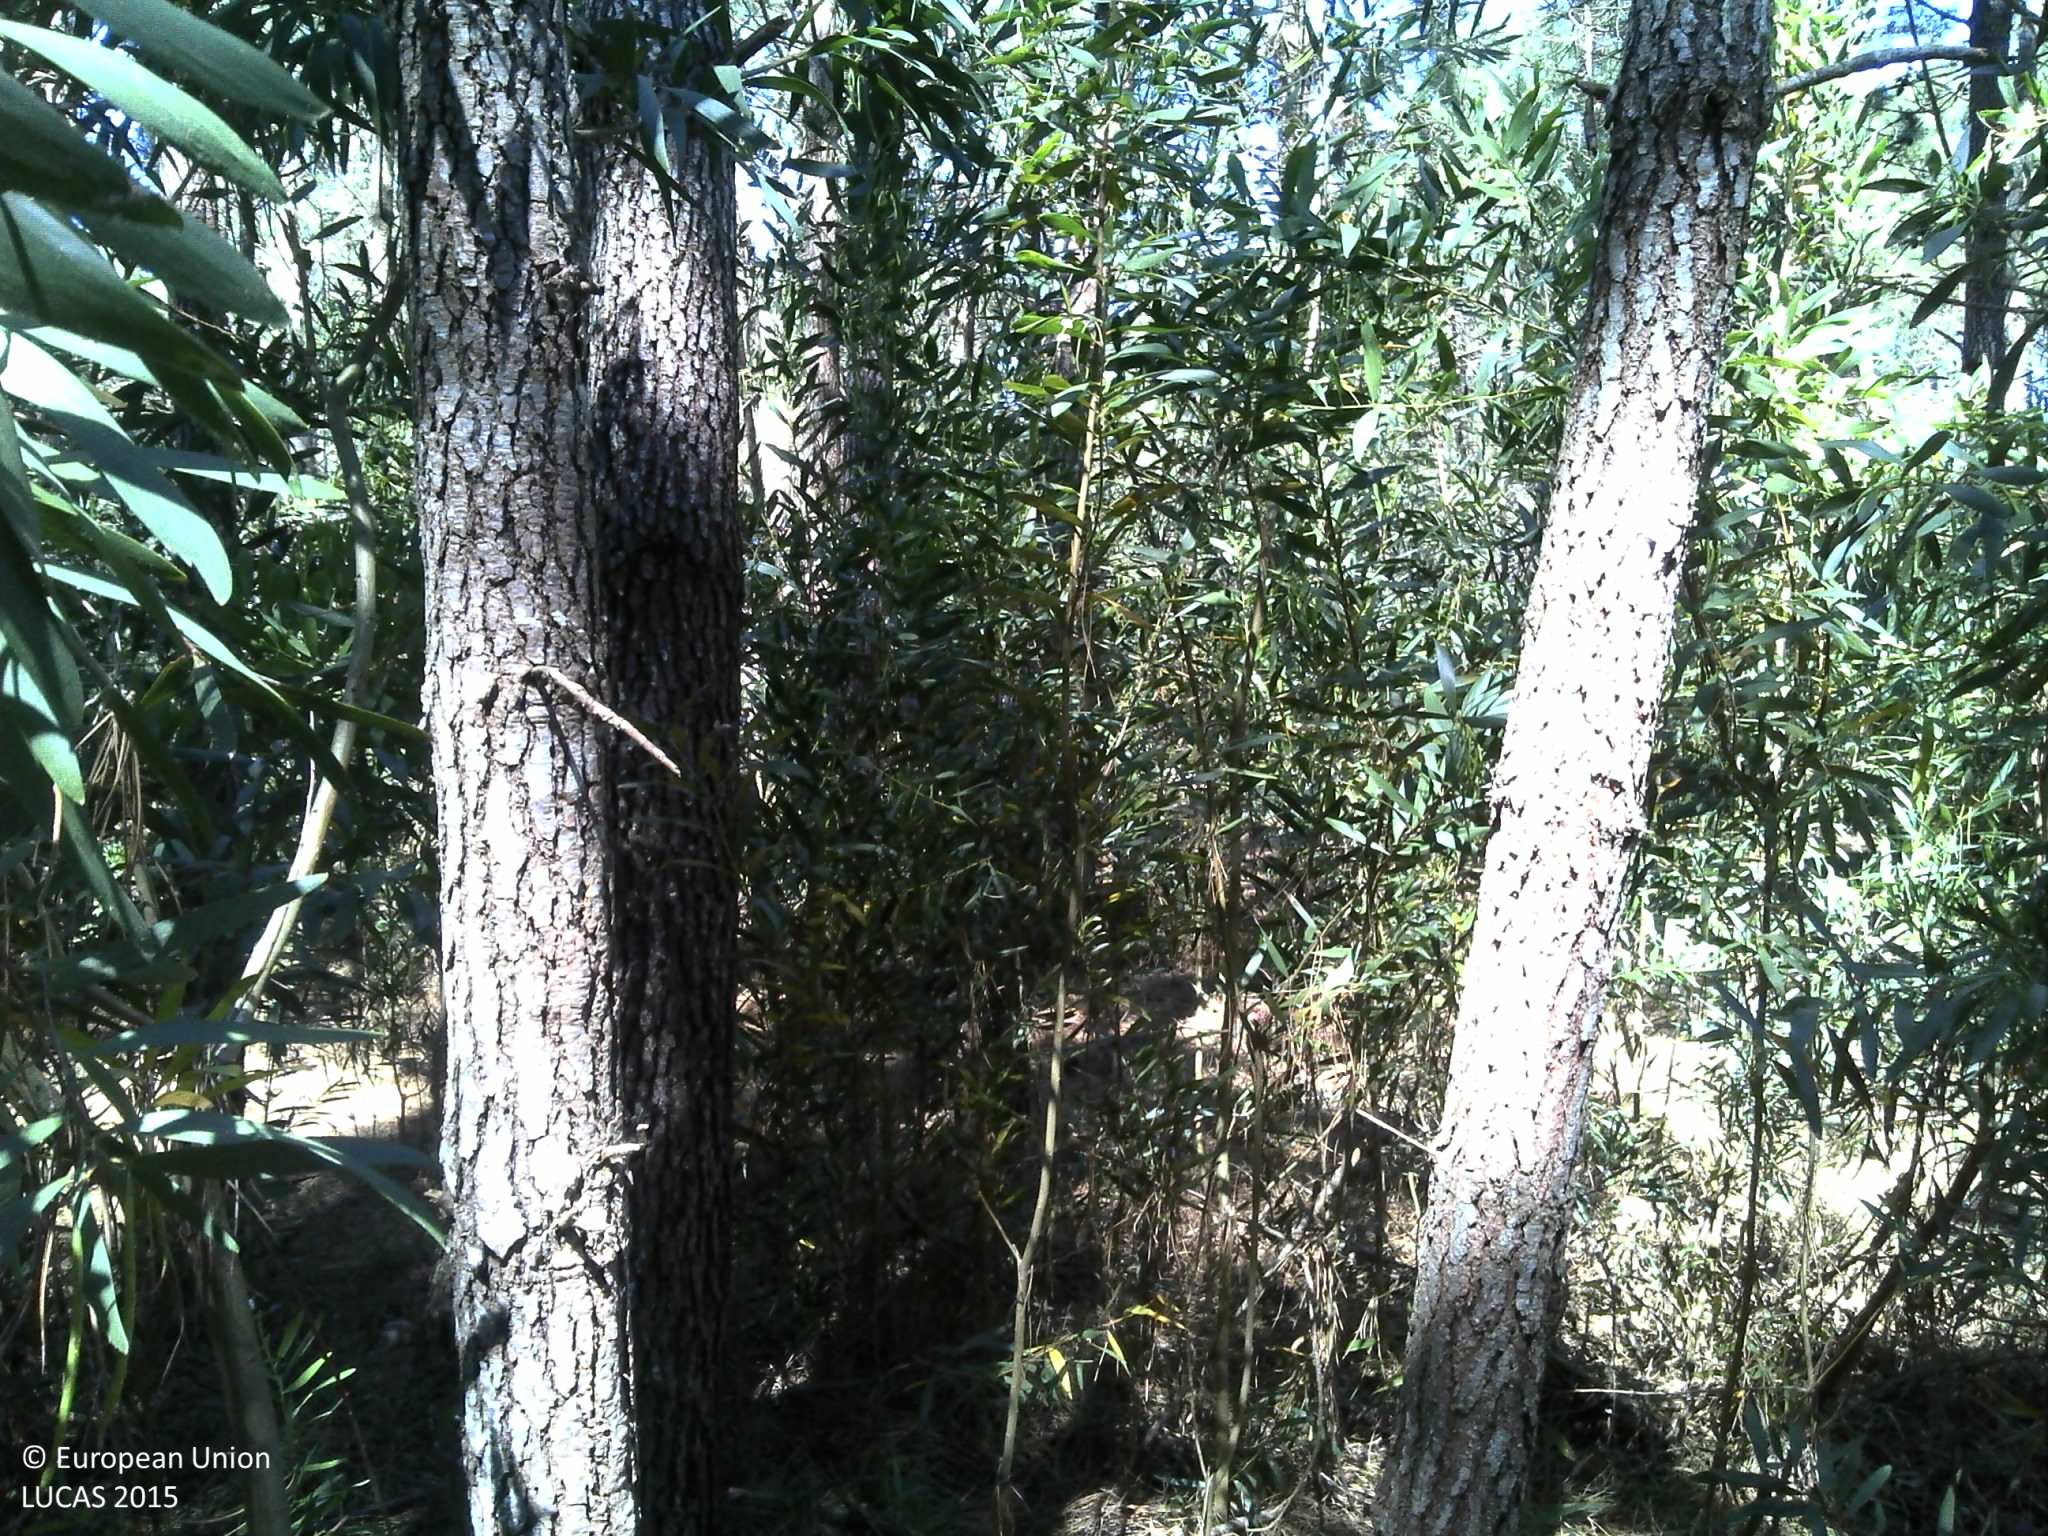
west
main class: Woodland
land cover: Pine dominated coniferous woodland
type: coniferous forest of the mediterranean region
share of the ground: 50 - 75 %
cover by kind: coniferous forest trees 65 %, shrubs 20 %, unconsolidated bare surface 15 %
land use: Forestry
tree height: > 5 m
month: May
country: PT
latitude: 40.5129
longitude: -8.7574
